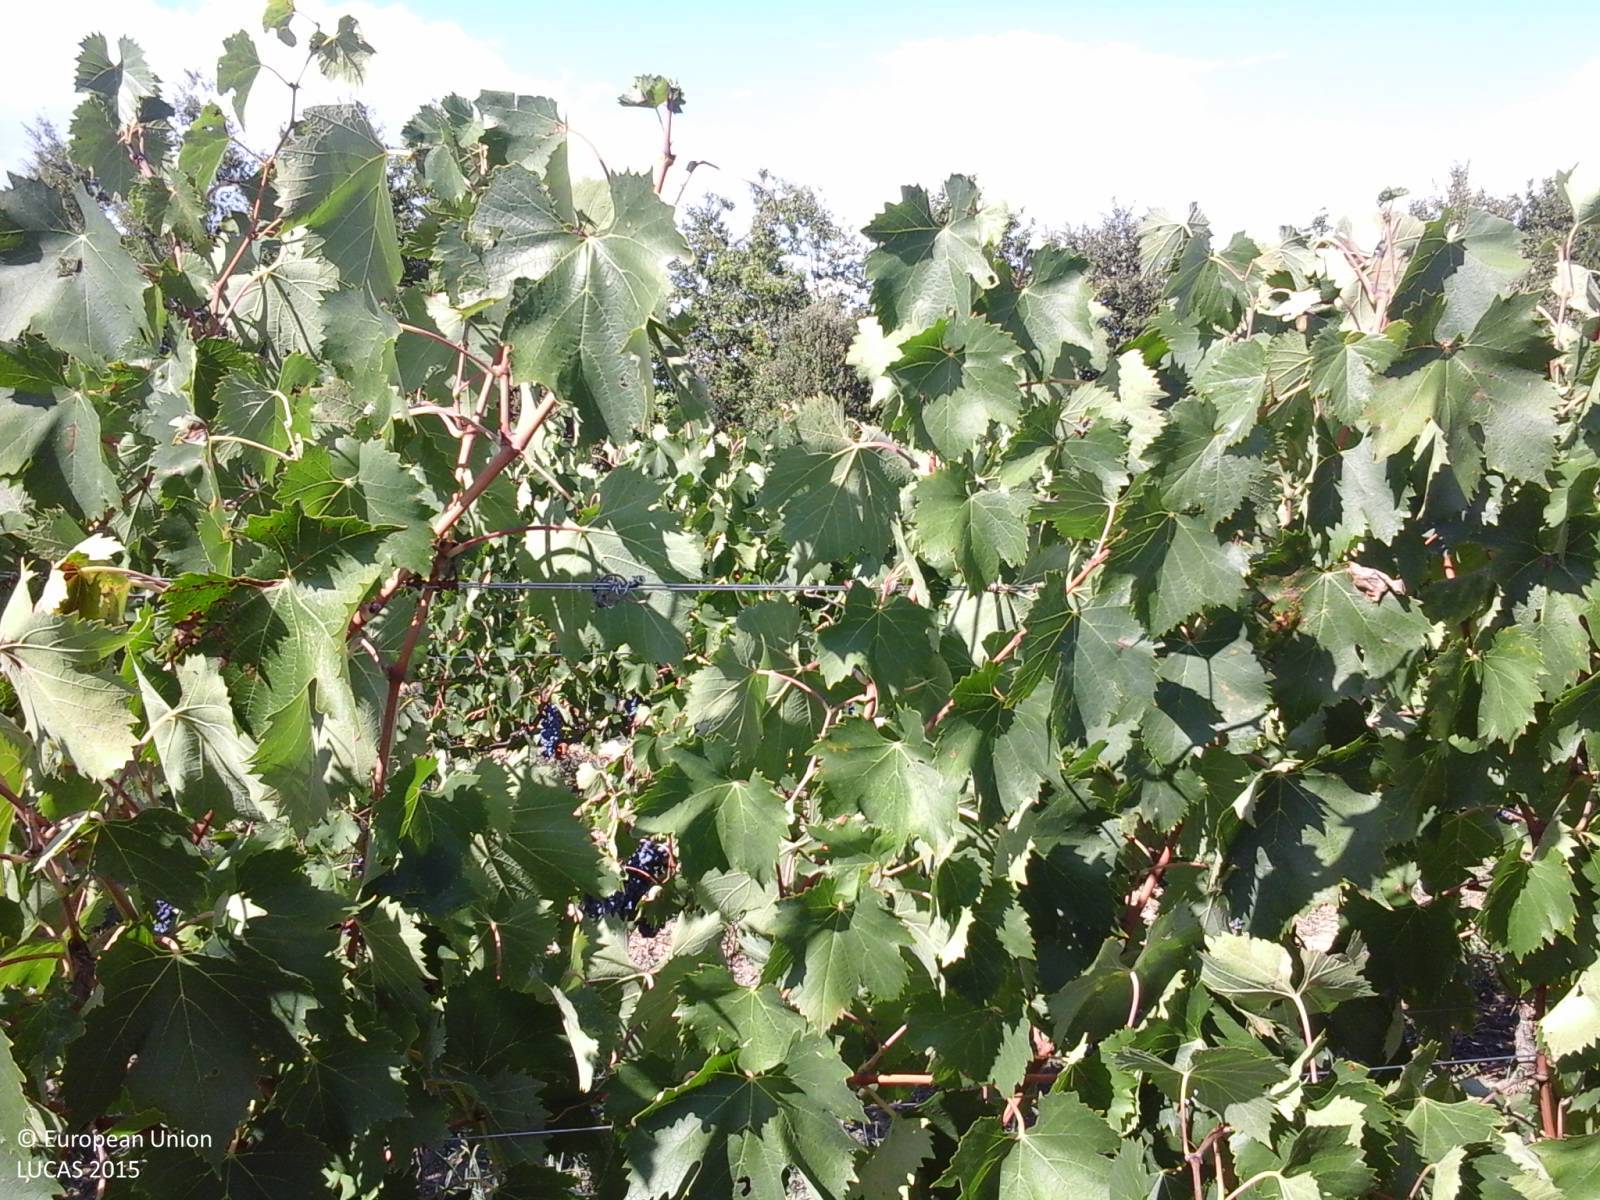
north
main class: Cropland
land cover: Vineyards
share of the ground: 25 - 50 %
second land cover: Spontaneously vegetated surfaces
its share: > 75 %
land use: Agriculture (excluding fallow land and kitchen gardens)
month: September
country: IT
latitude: 43.0659
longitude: 12.0936
